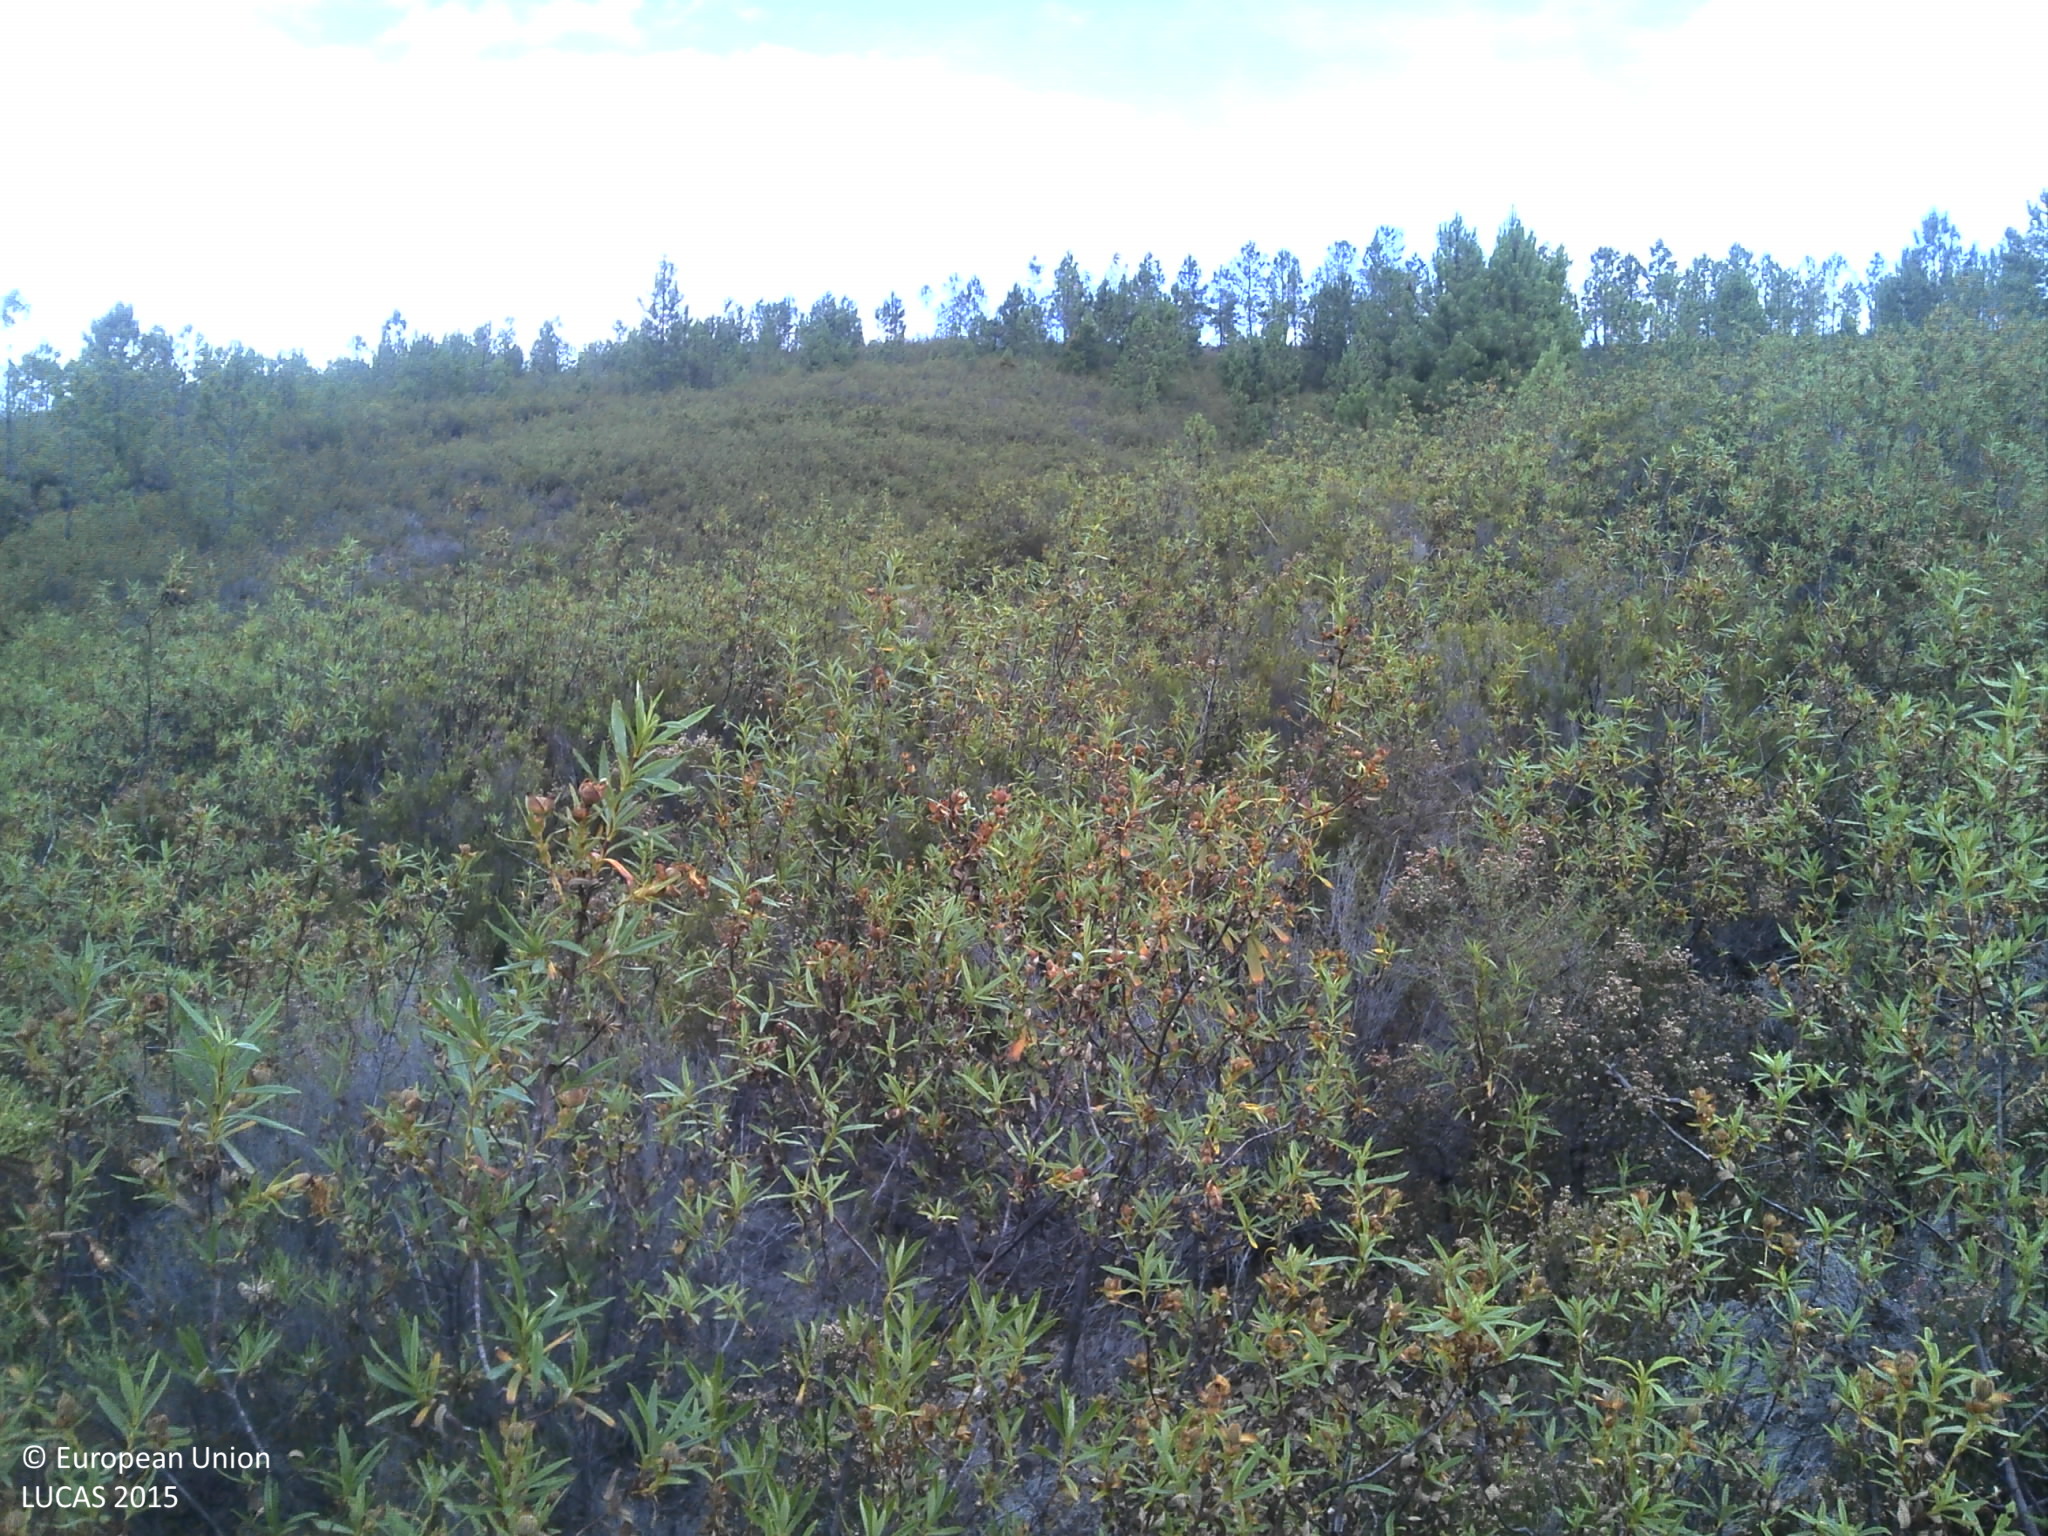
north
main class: Woodland
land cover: Pine dominated coniferous woodland
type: coniferous forest of the mediterranean region
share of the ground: 10 - 25 %
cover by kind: shrubs 55 %, coniferous forest trees 25 %, unconsolidated bare surface 20 %
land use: Forestry
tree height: > 5 m
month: June
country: PT
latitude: 40.1266
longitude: -7.3633
